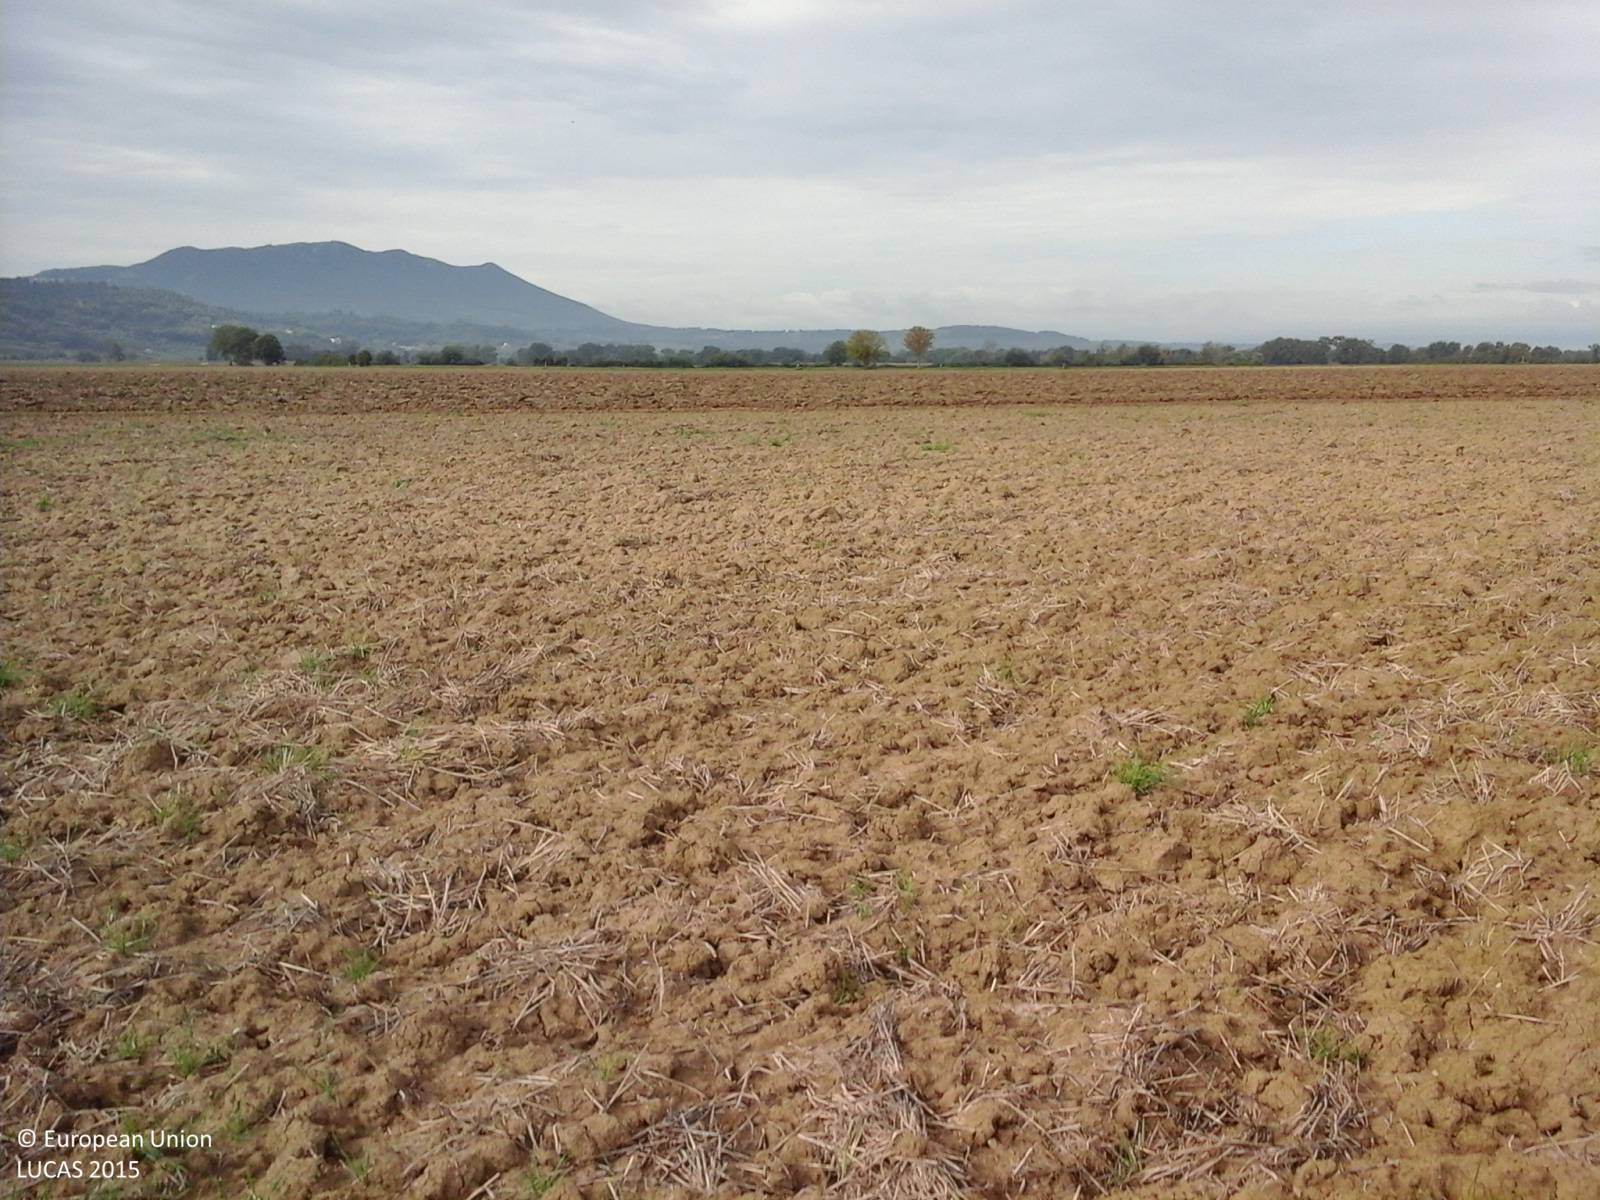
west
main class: Cropland
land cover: Durum wheat
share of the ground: < 10 %
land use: Agriculture (excluding fallow land and kitchen gardens)
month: October
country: IT
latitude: 42.2773
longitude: 12.5981
